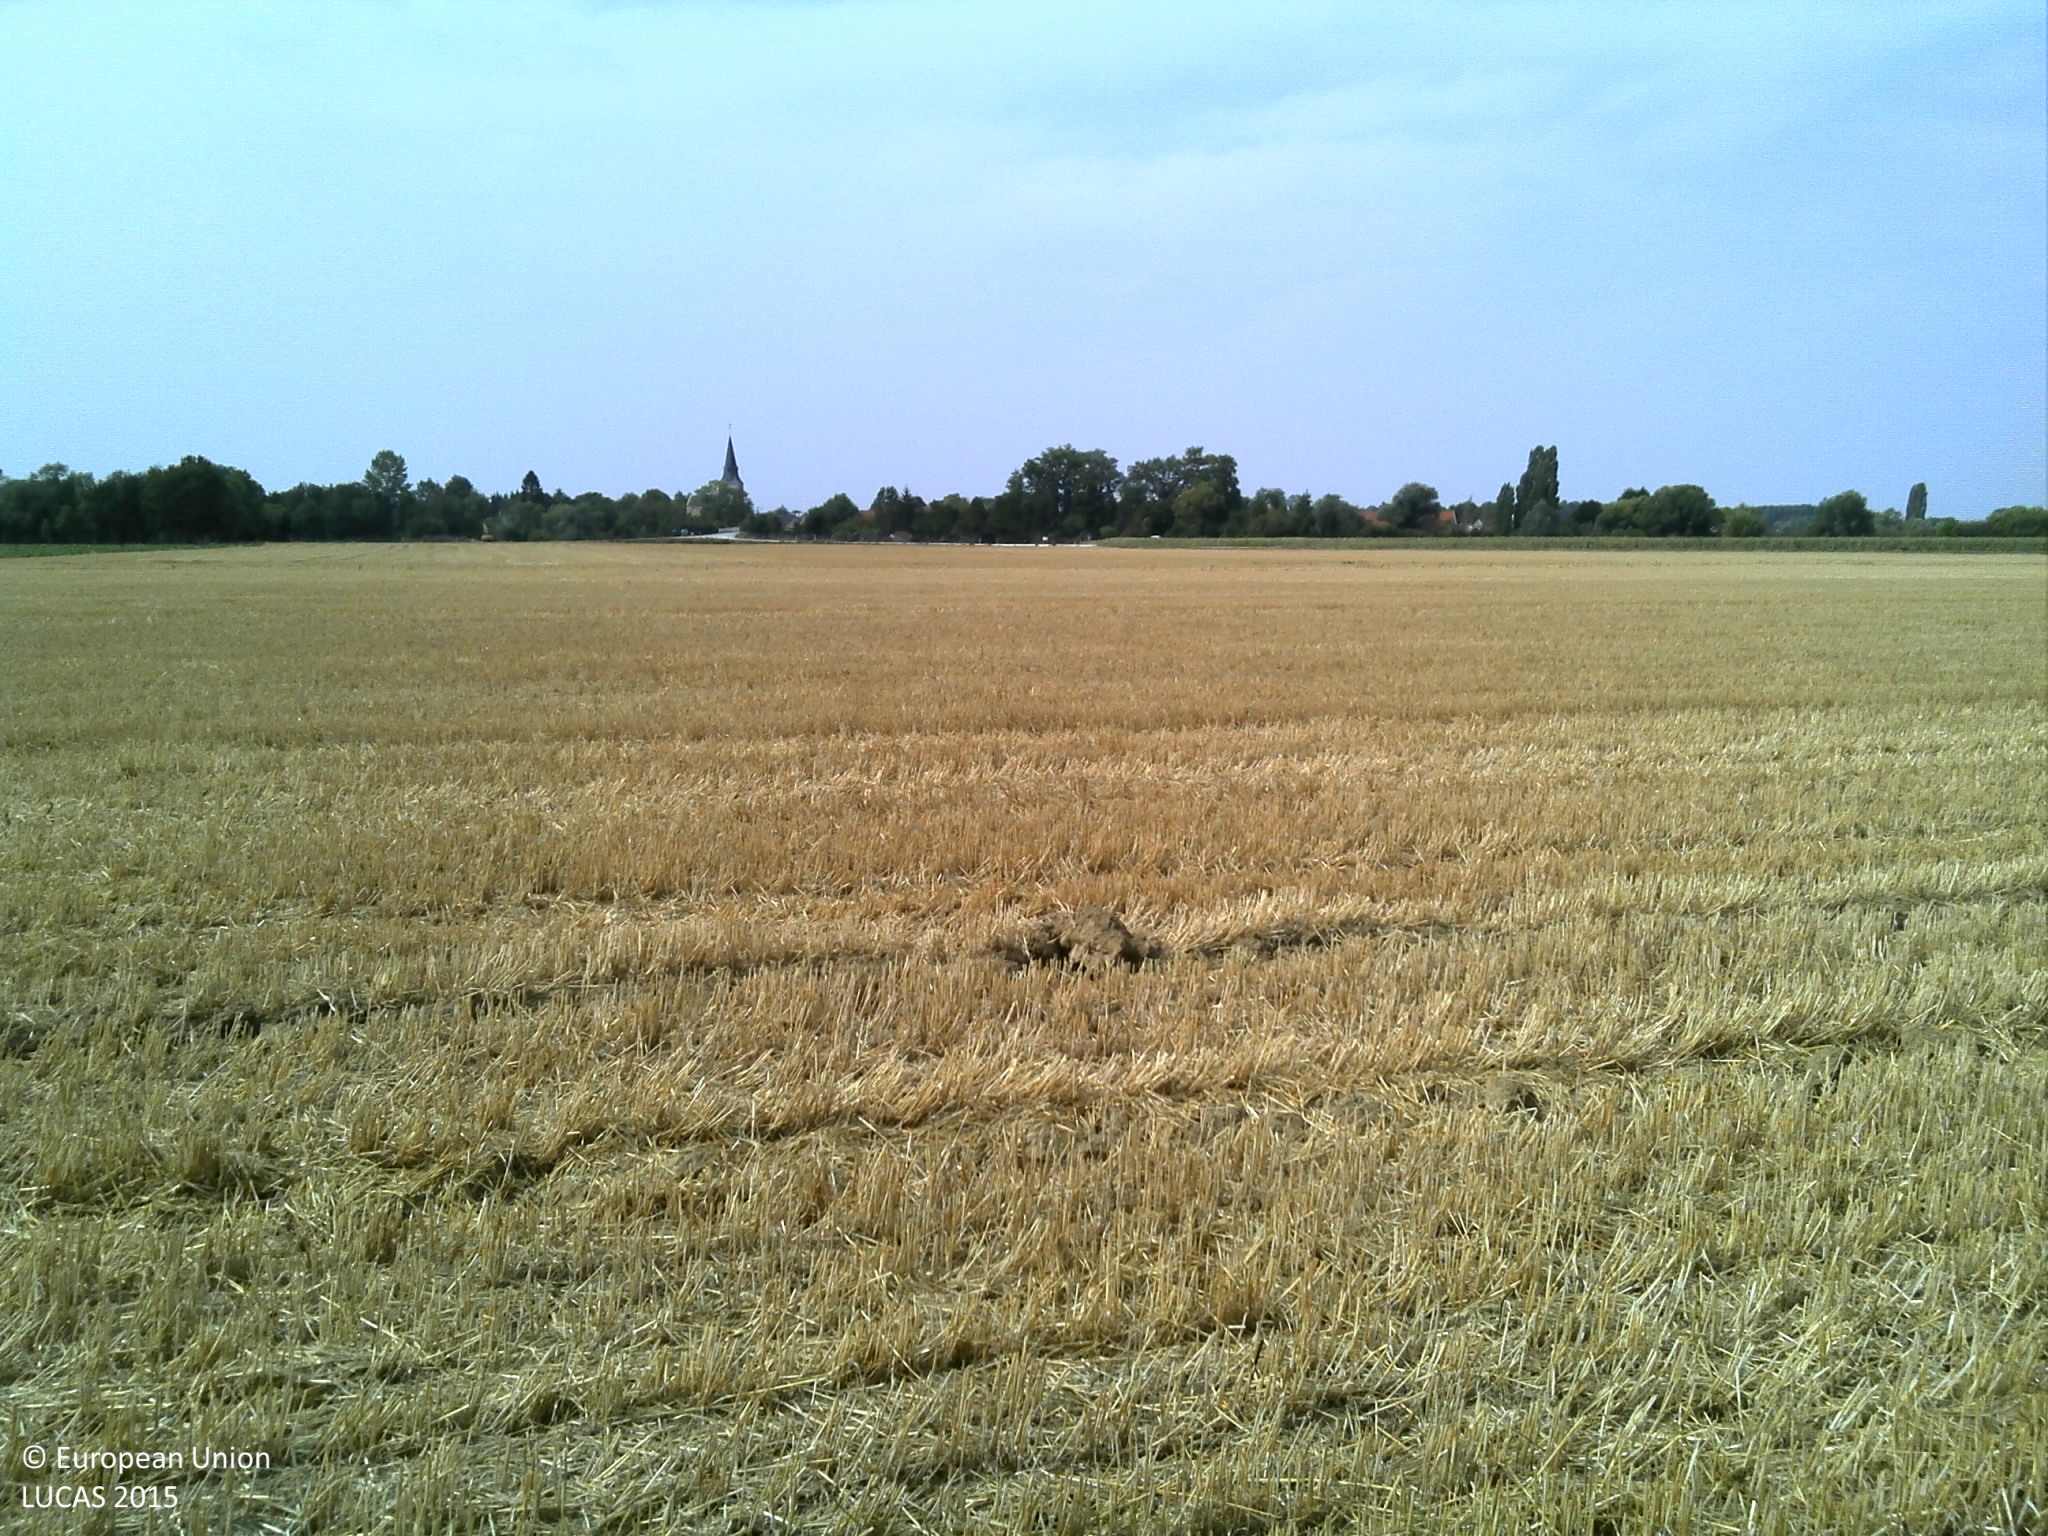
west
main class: Cropland
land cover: Barley
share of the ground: > 75 %
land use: Agriculture (excluding fallow land and kitchen gardens)
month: August
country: FR
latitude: 49.0095
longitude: 4.2128
